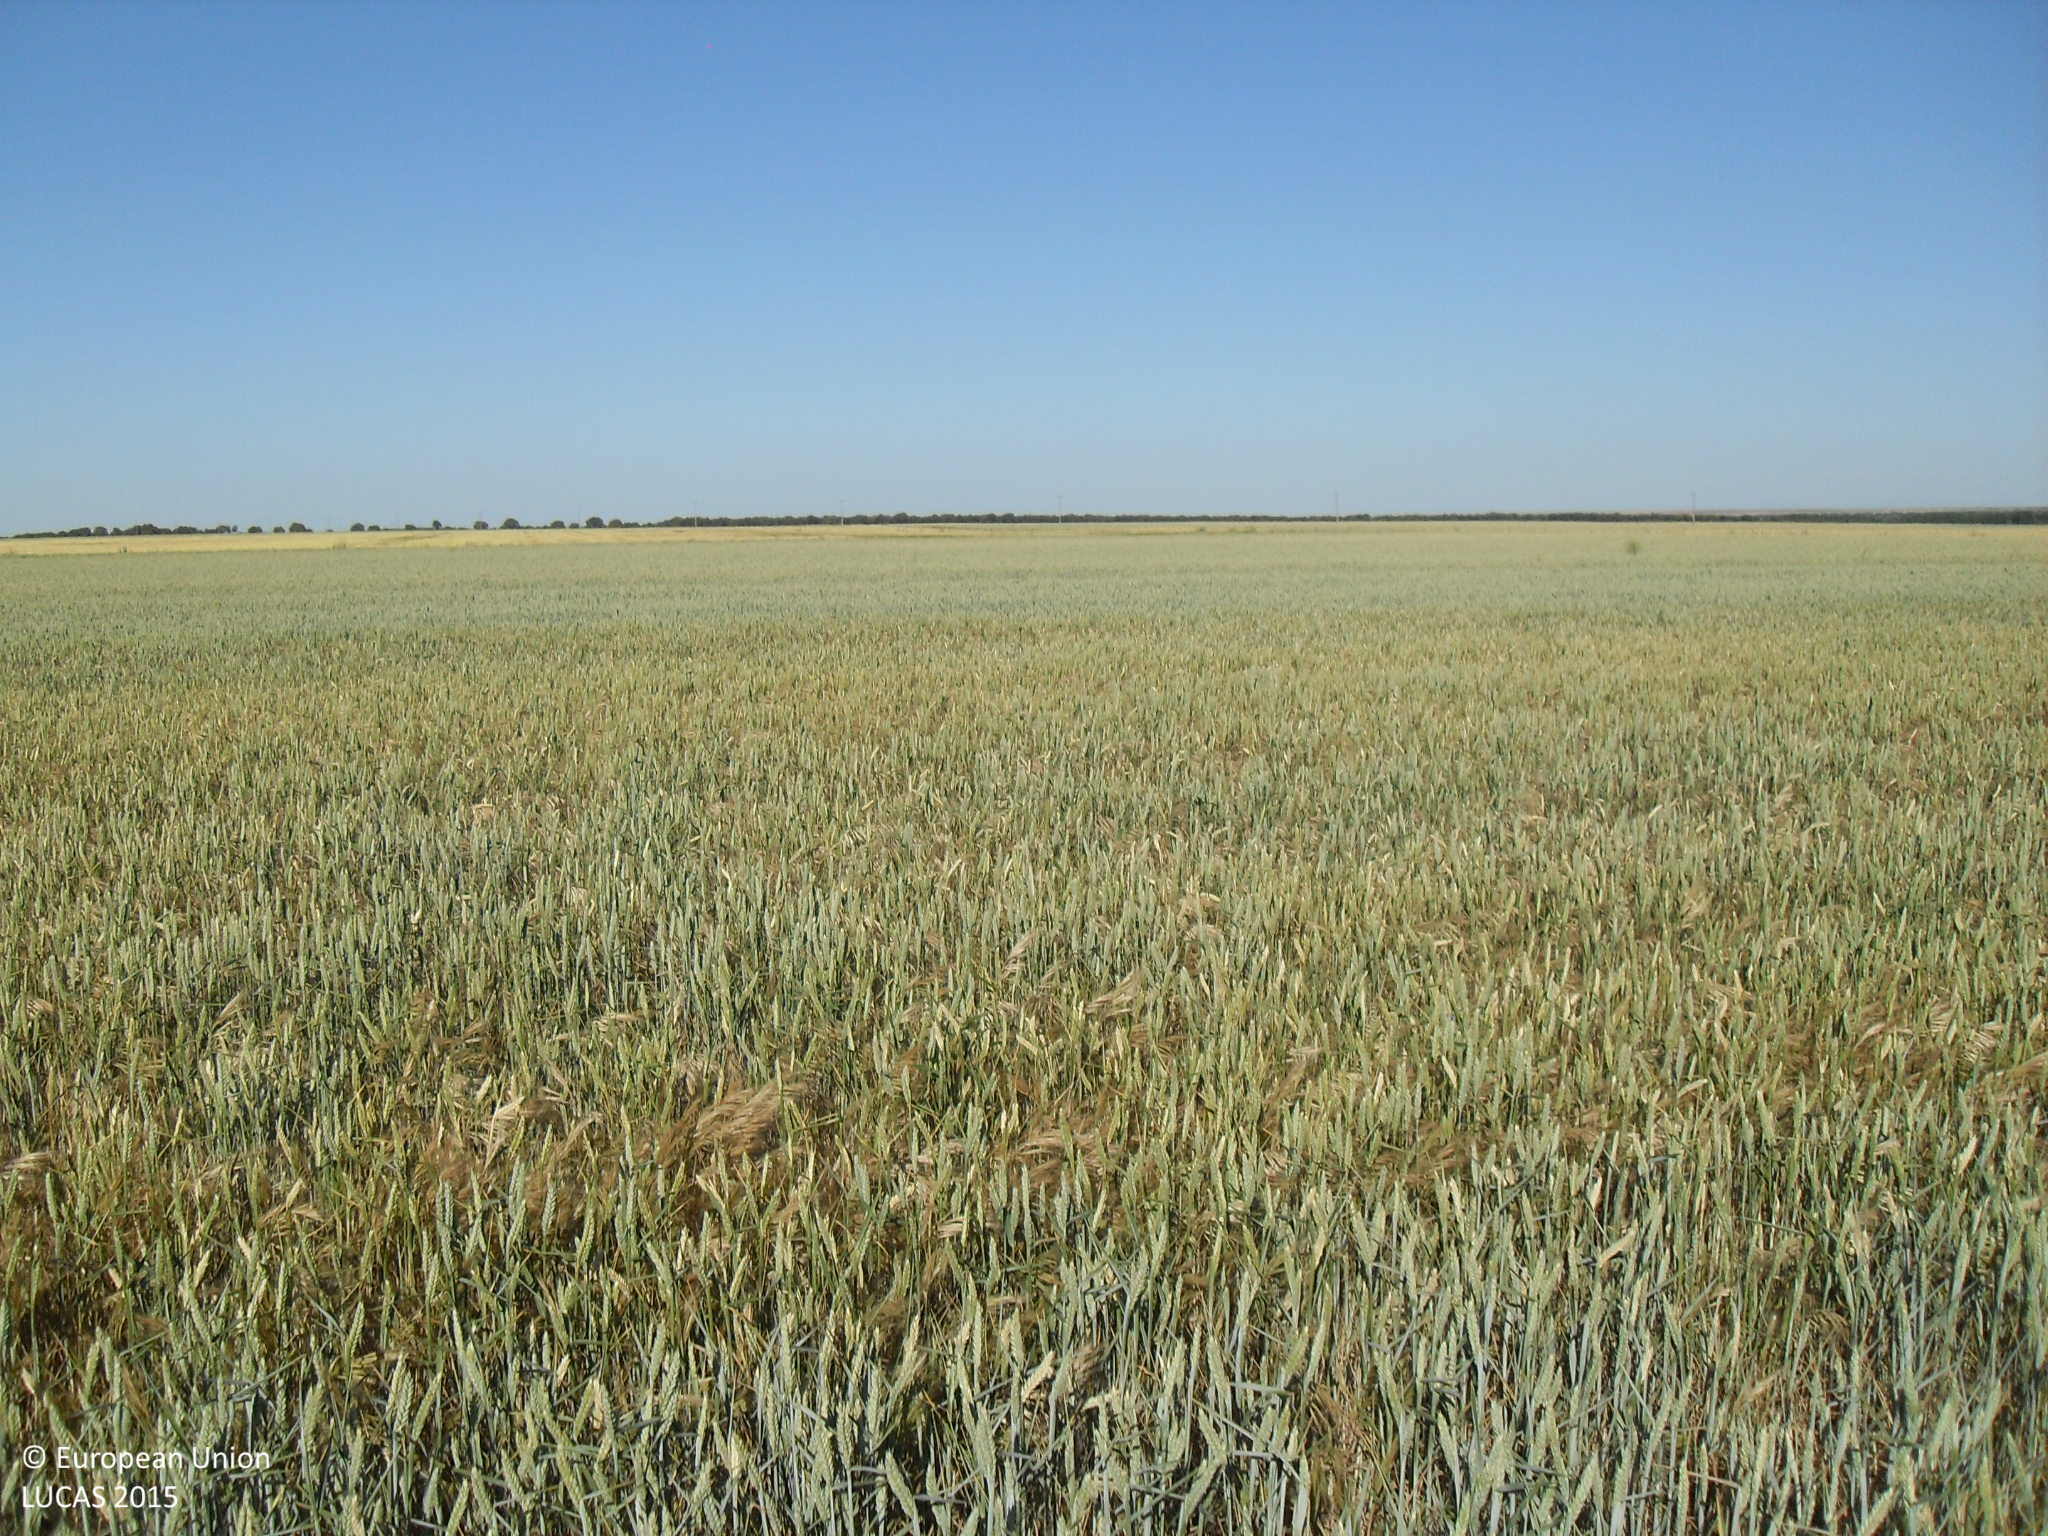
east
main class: Cropland
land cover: Common wheat
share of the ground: > 75 %
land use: Agriculture (excluding fallow land and kitchen gardens)
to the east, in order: Common wheat; Grass margins; Common wheat; Grass margins; Tracks; Grass margins; Barley; Grass margins; Tracks; Grass margins; Barley
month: May
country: ES
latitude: 41.1189
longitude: -5.4024
